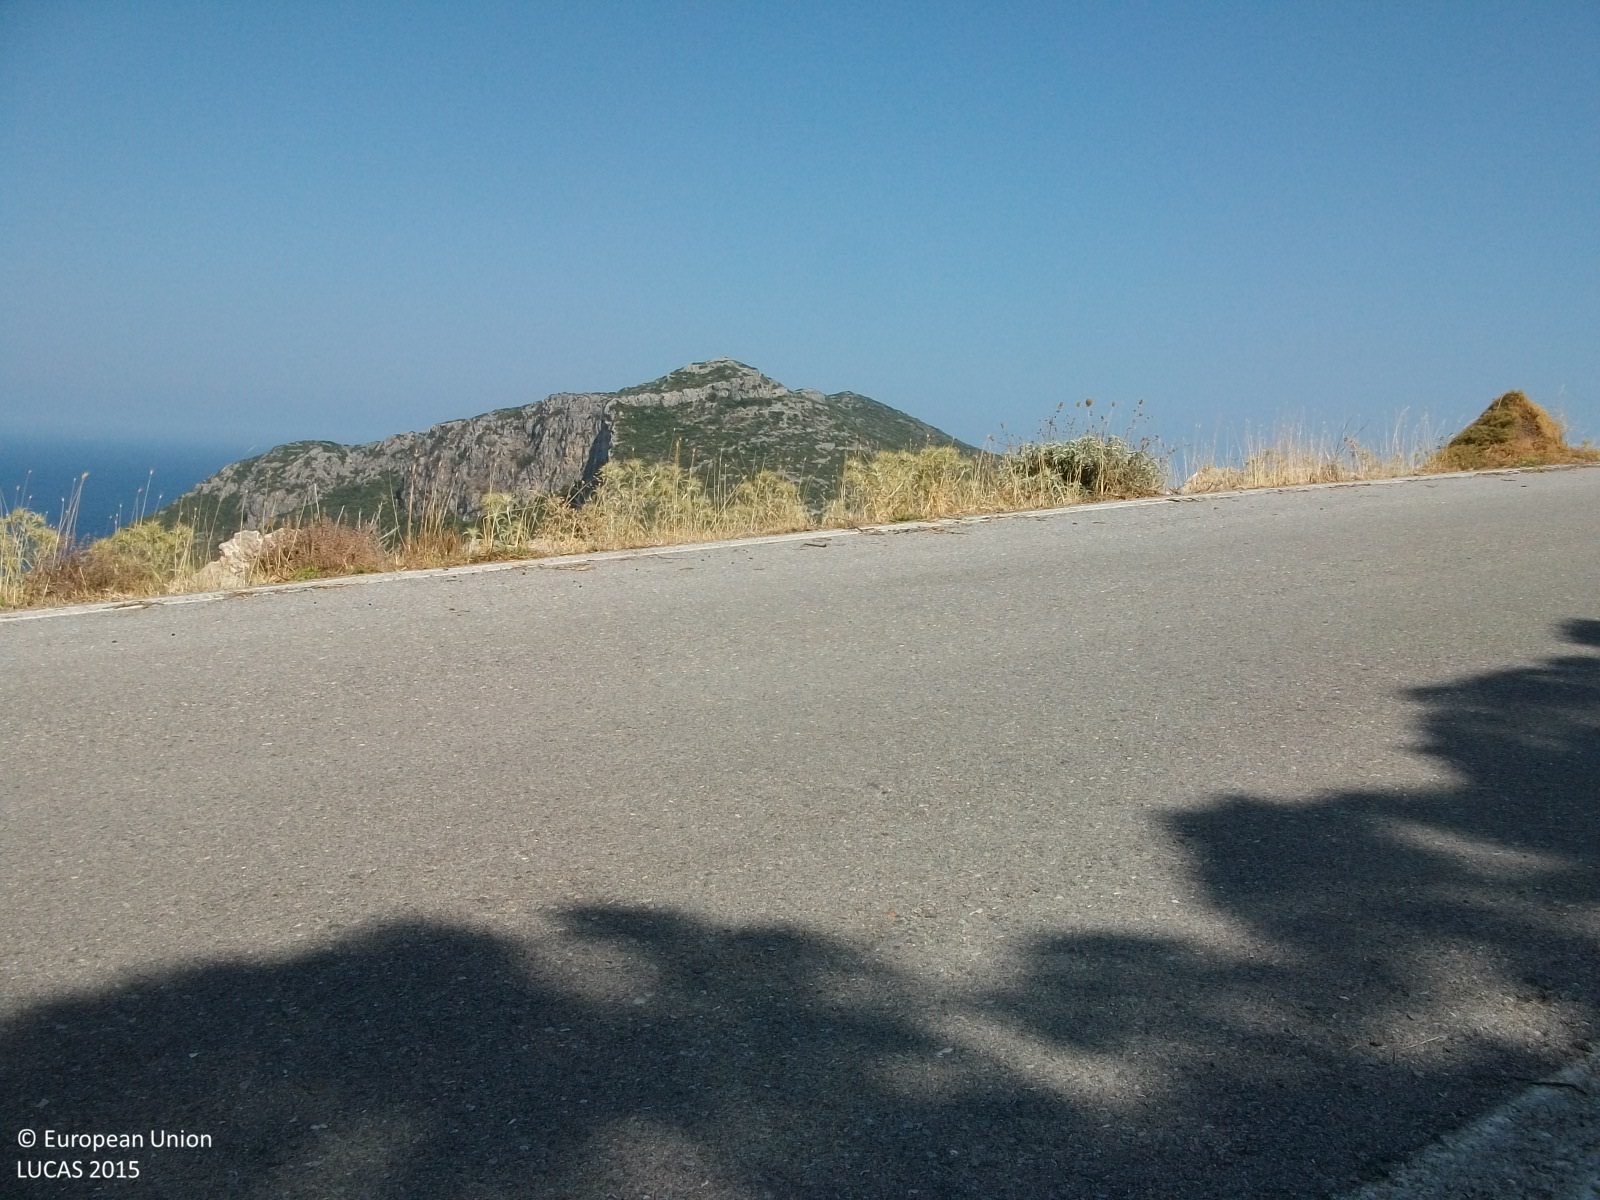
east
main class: Shrubland
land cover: Shrubland without tree cover
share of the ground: > 75 %
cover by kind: shrubs 95 %, unconsolidated bare surface 5 %
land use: Semi-natural and natural areas not in use
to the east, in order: Shrubland without tree cover; Paved roads, cycling and walking lanes; Shrubland without tree cover; Rocks and stones; Shrubland without tree cover
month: August
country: GR
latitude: 36.5403
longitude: 23.1221
